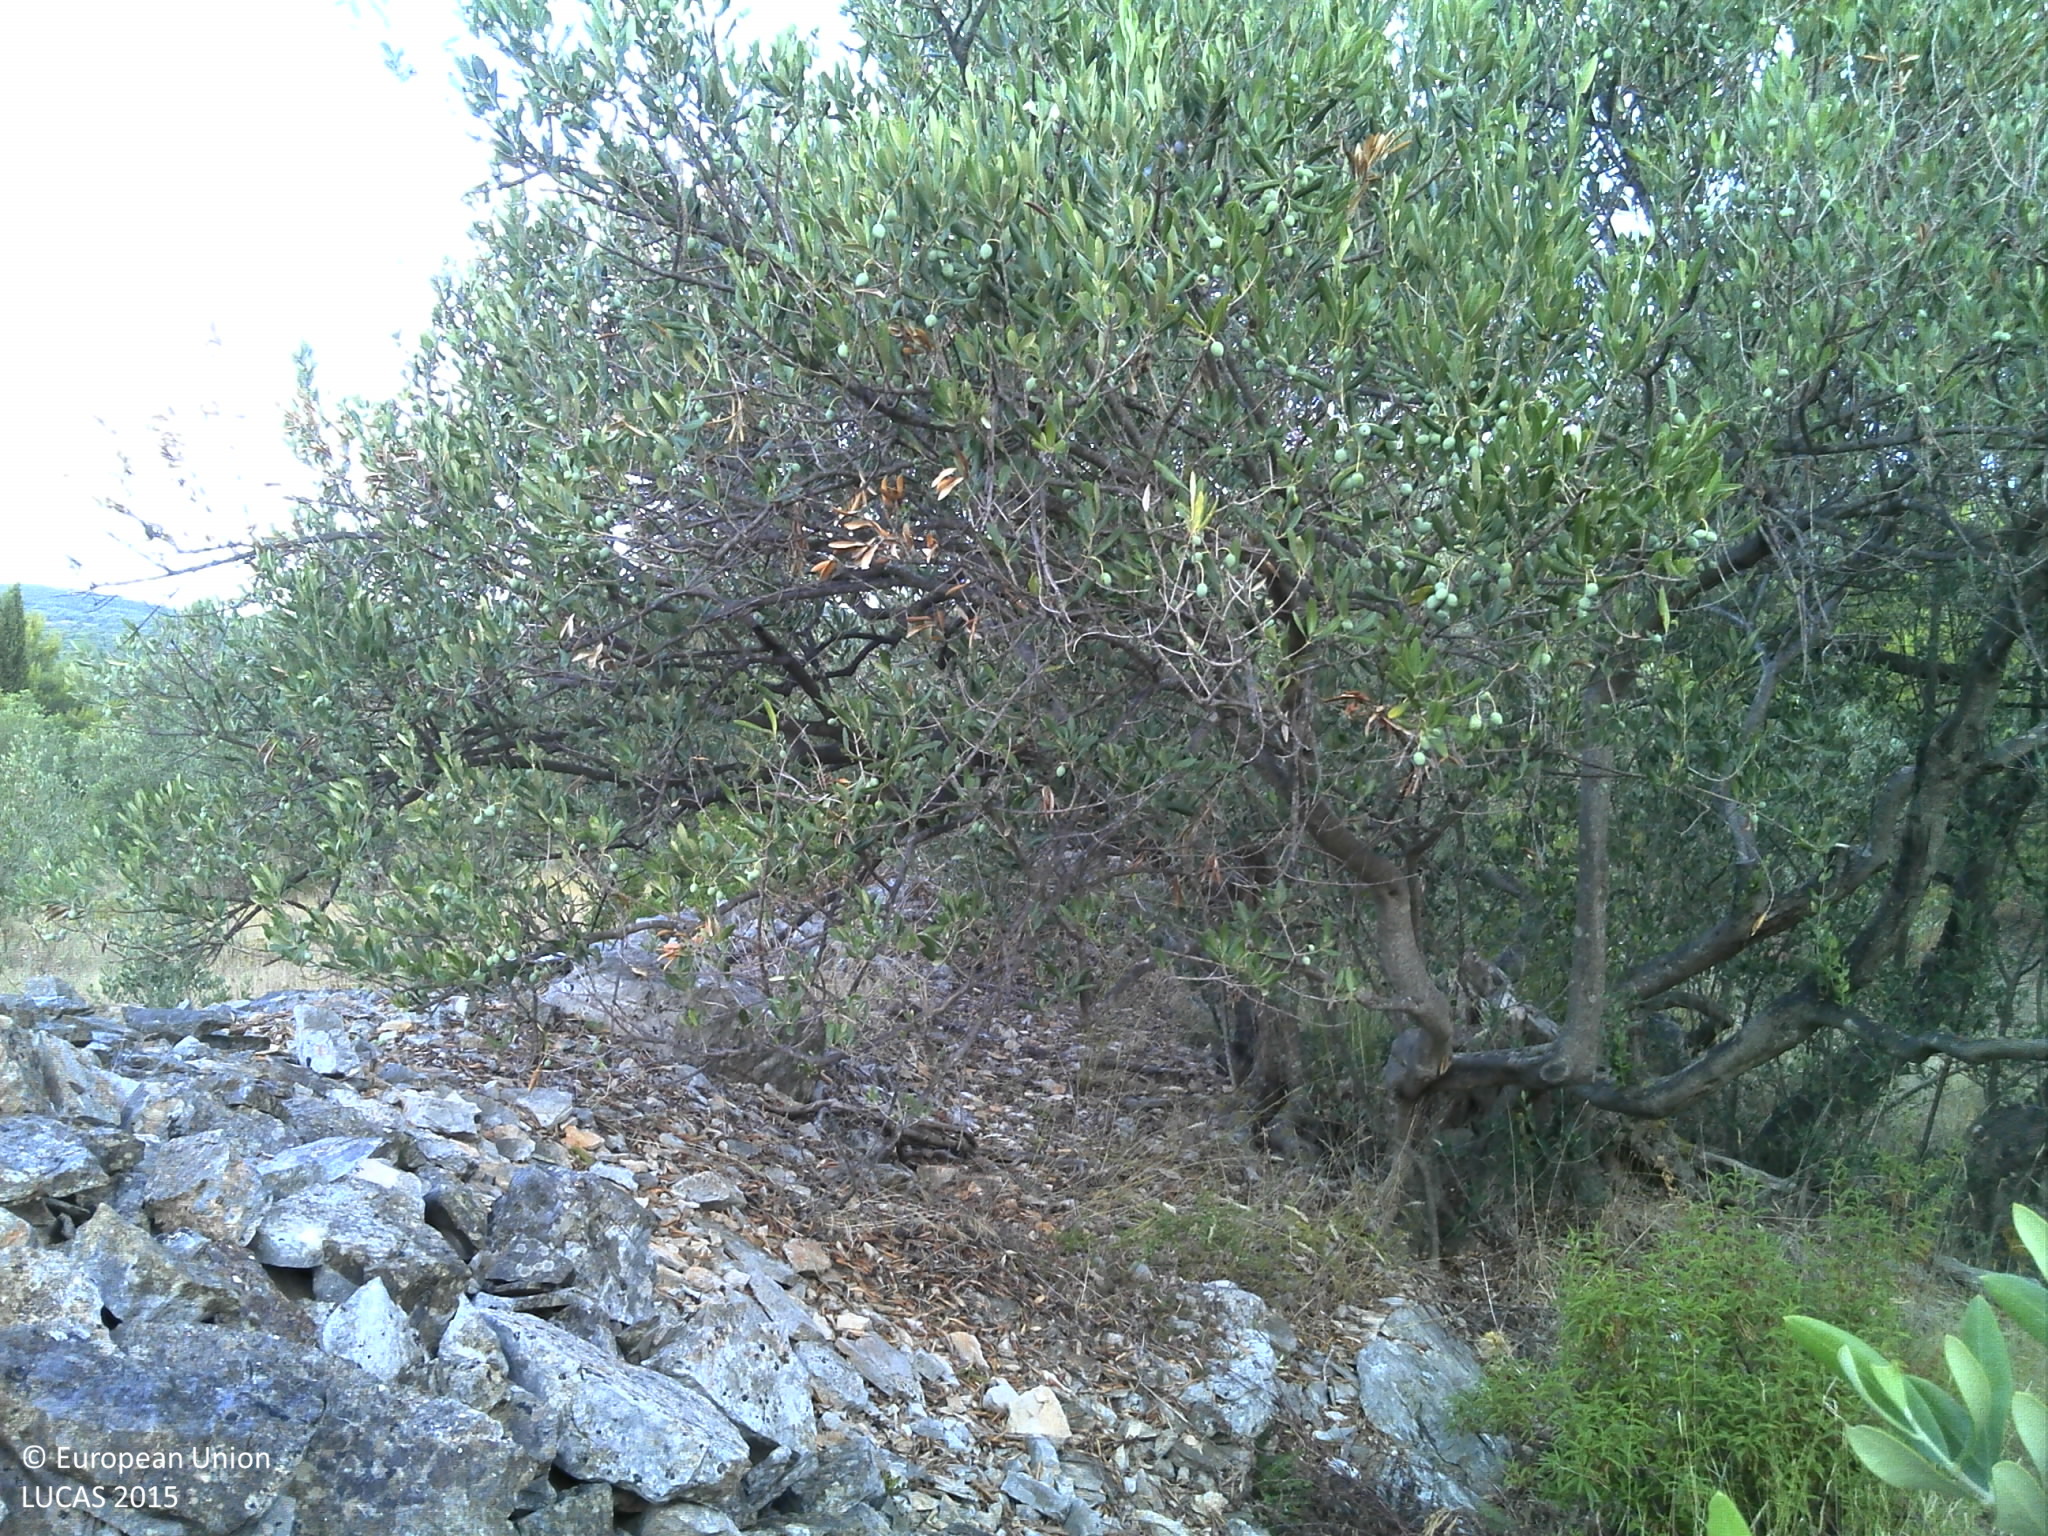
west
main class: Cropland
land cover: Olive groves
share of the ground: 50 - 75 %
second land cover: Other bare soil
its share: > 75 %
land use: Agriculture (excluding fallow land and kitchen gardens)
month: August
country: HR
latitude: 43.4008
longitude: 16.2749
